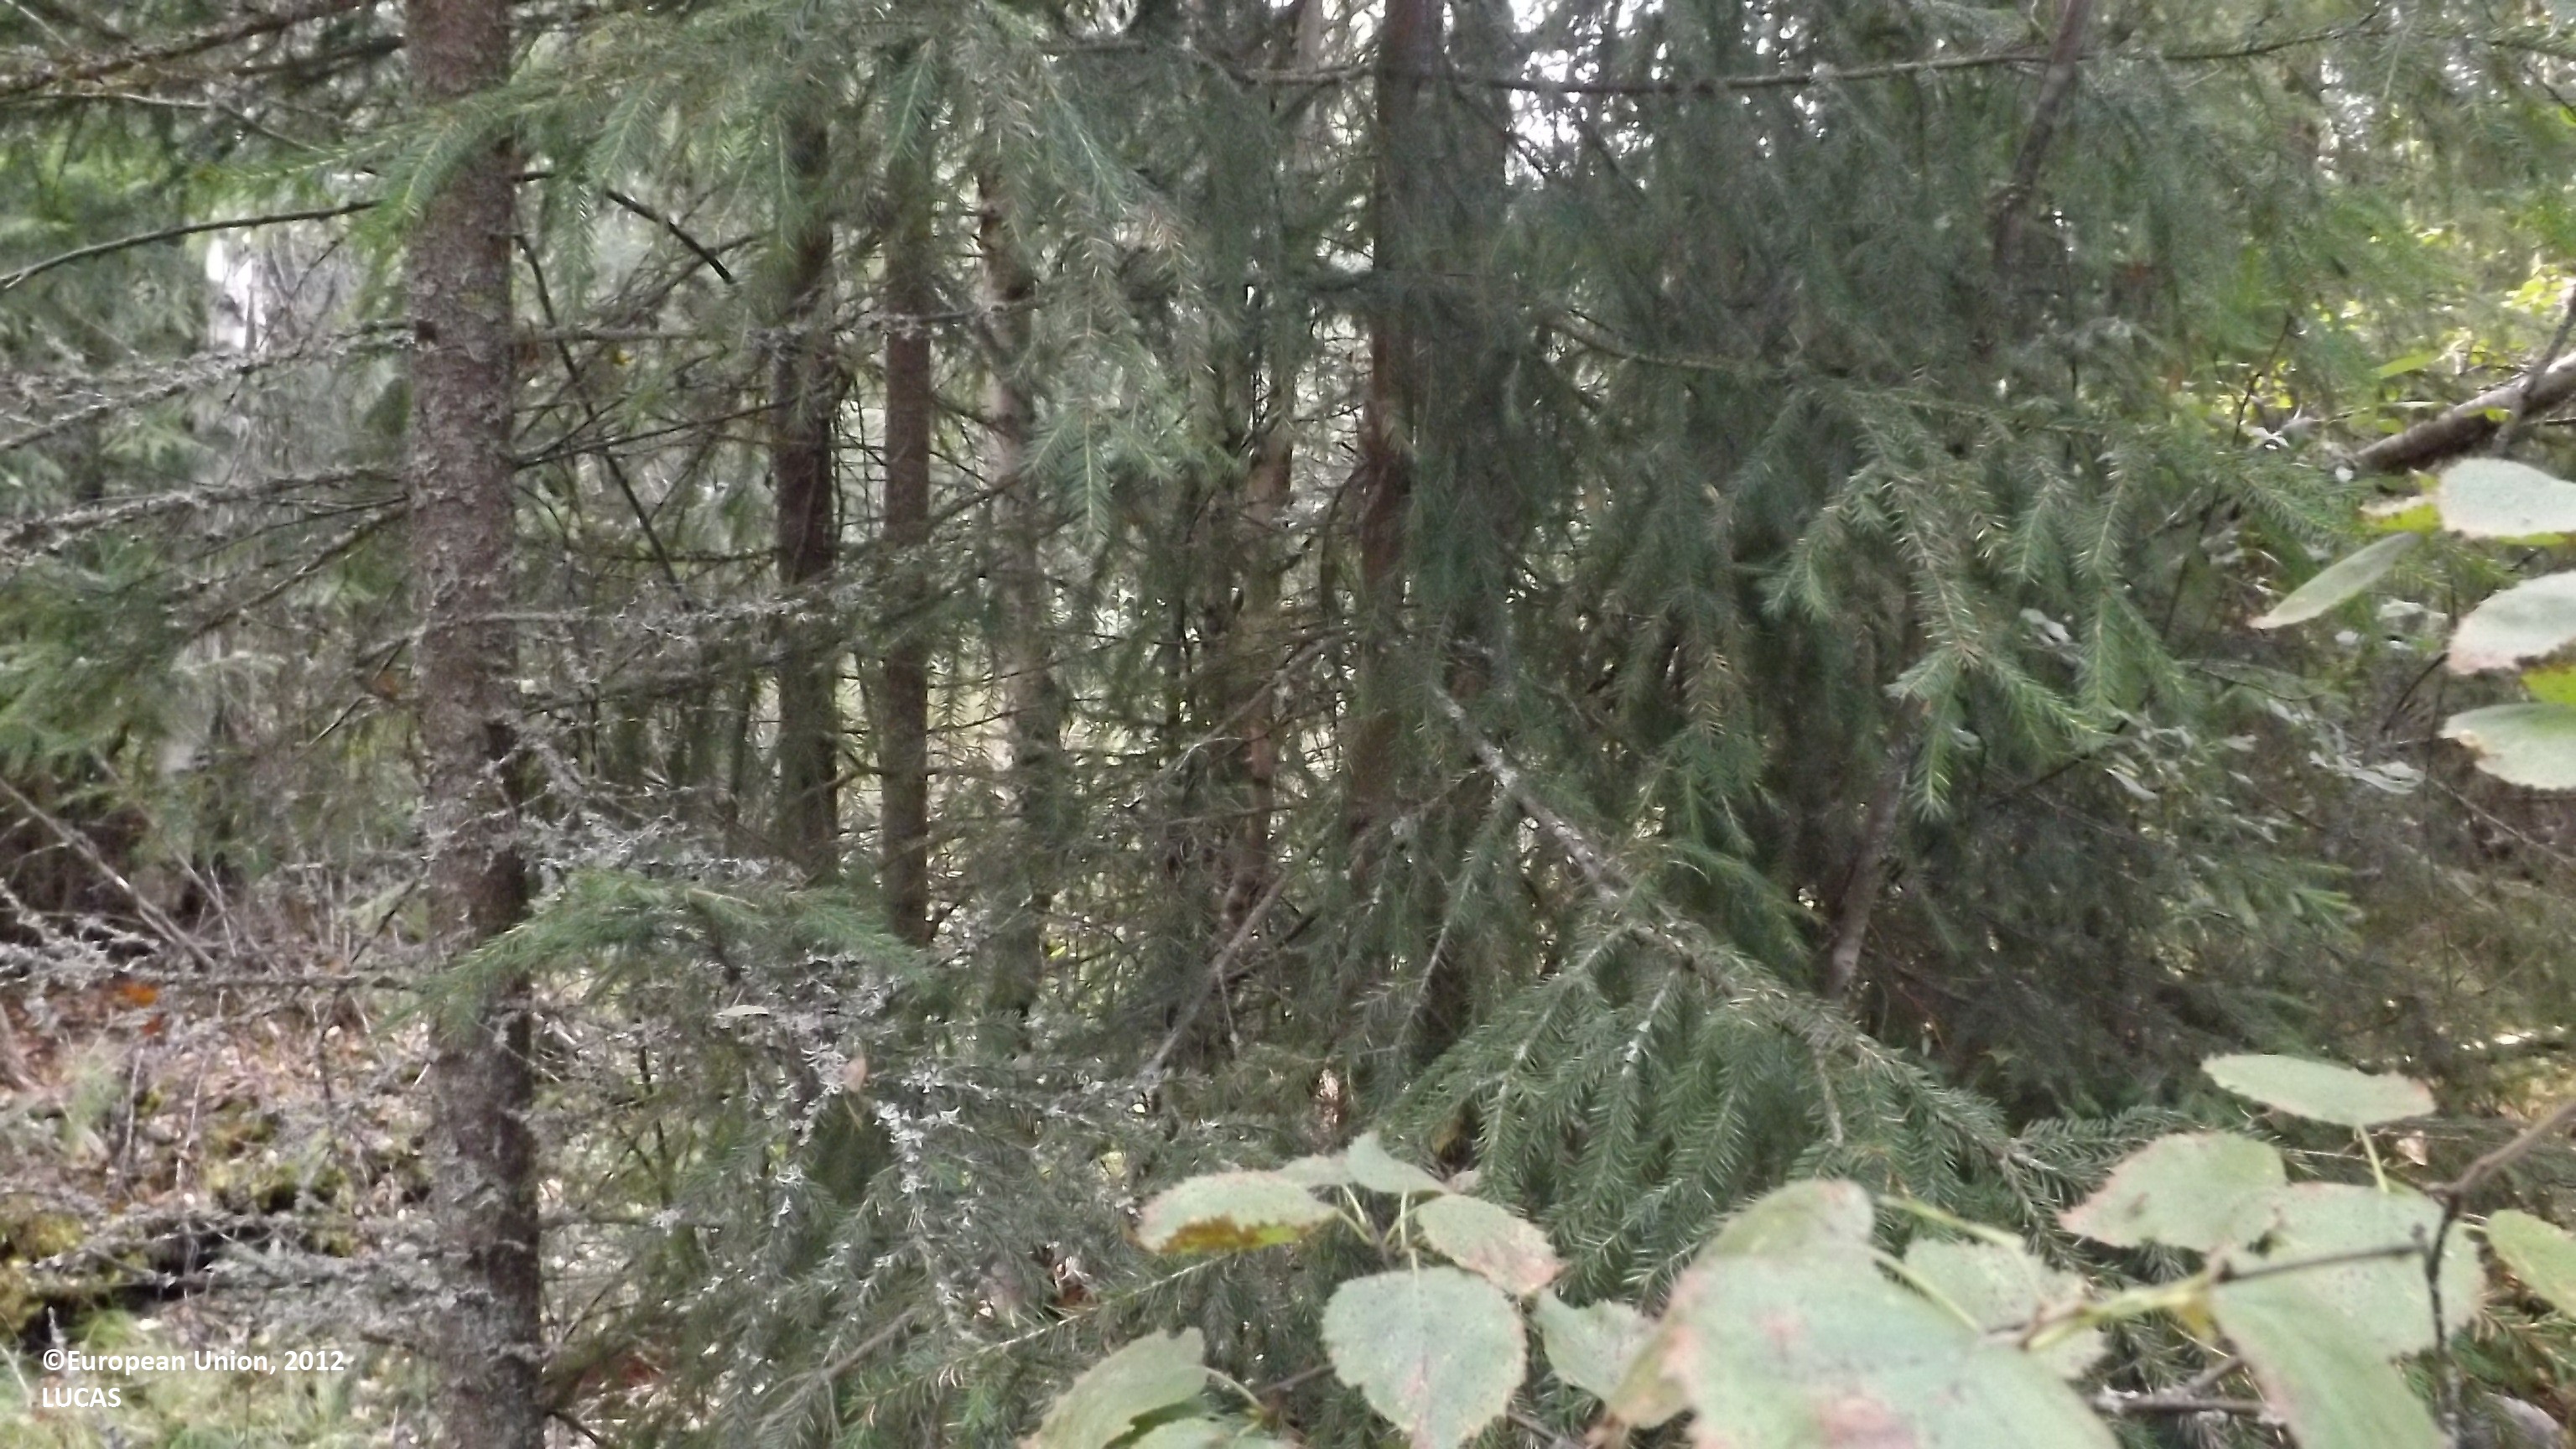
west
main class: Woodland
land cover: Other mixed woodland
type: boreal forest
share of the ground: > 75 %
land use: Forestry
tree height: > 5 m
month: August
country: FI
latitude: 63.7382
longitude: 23.9841
